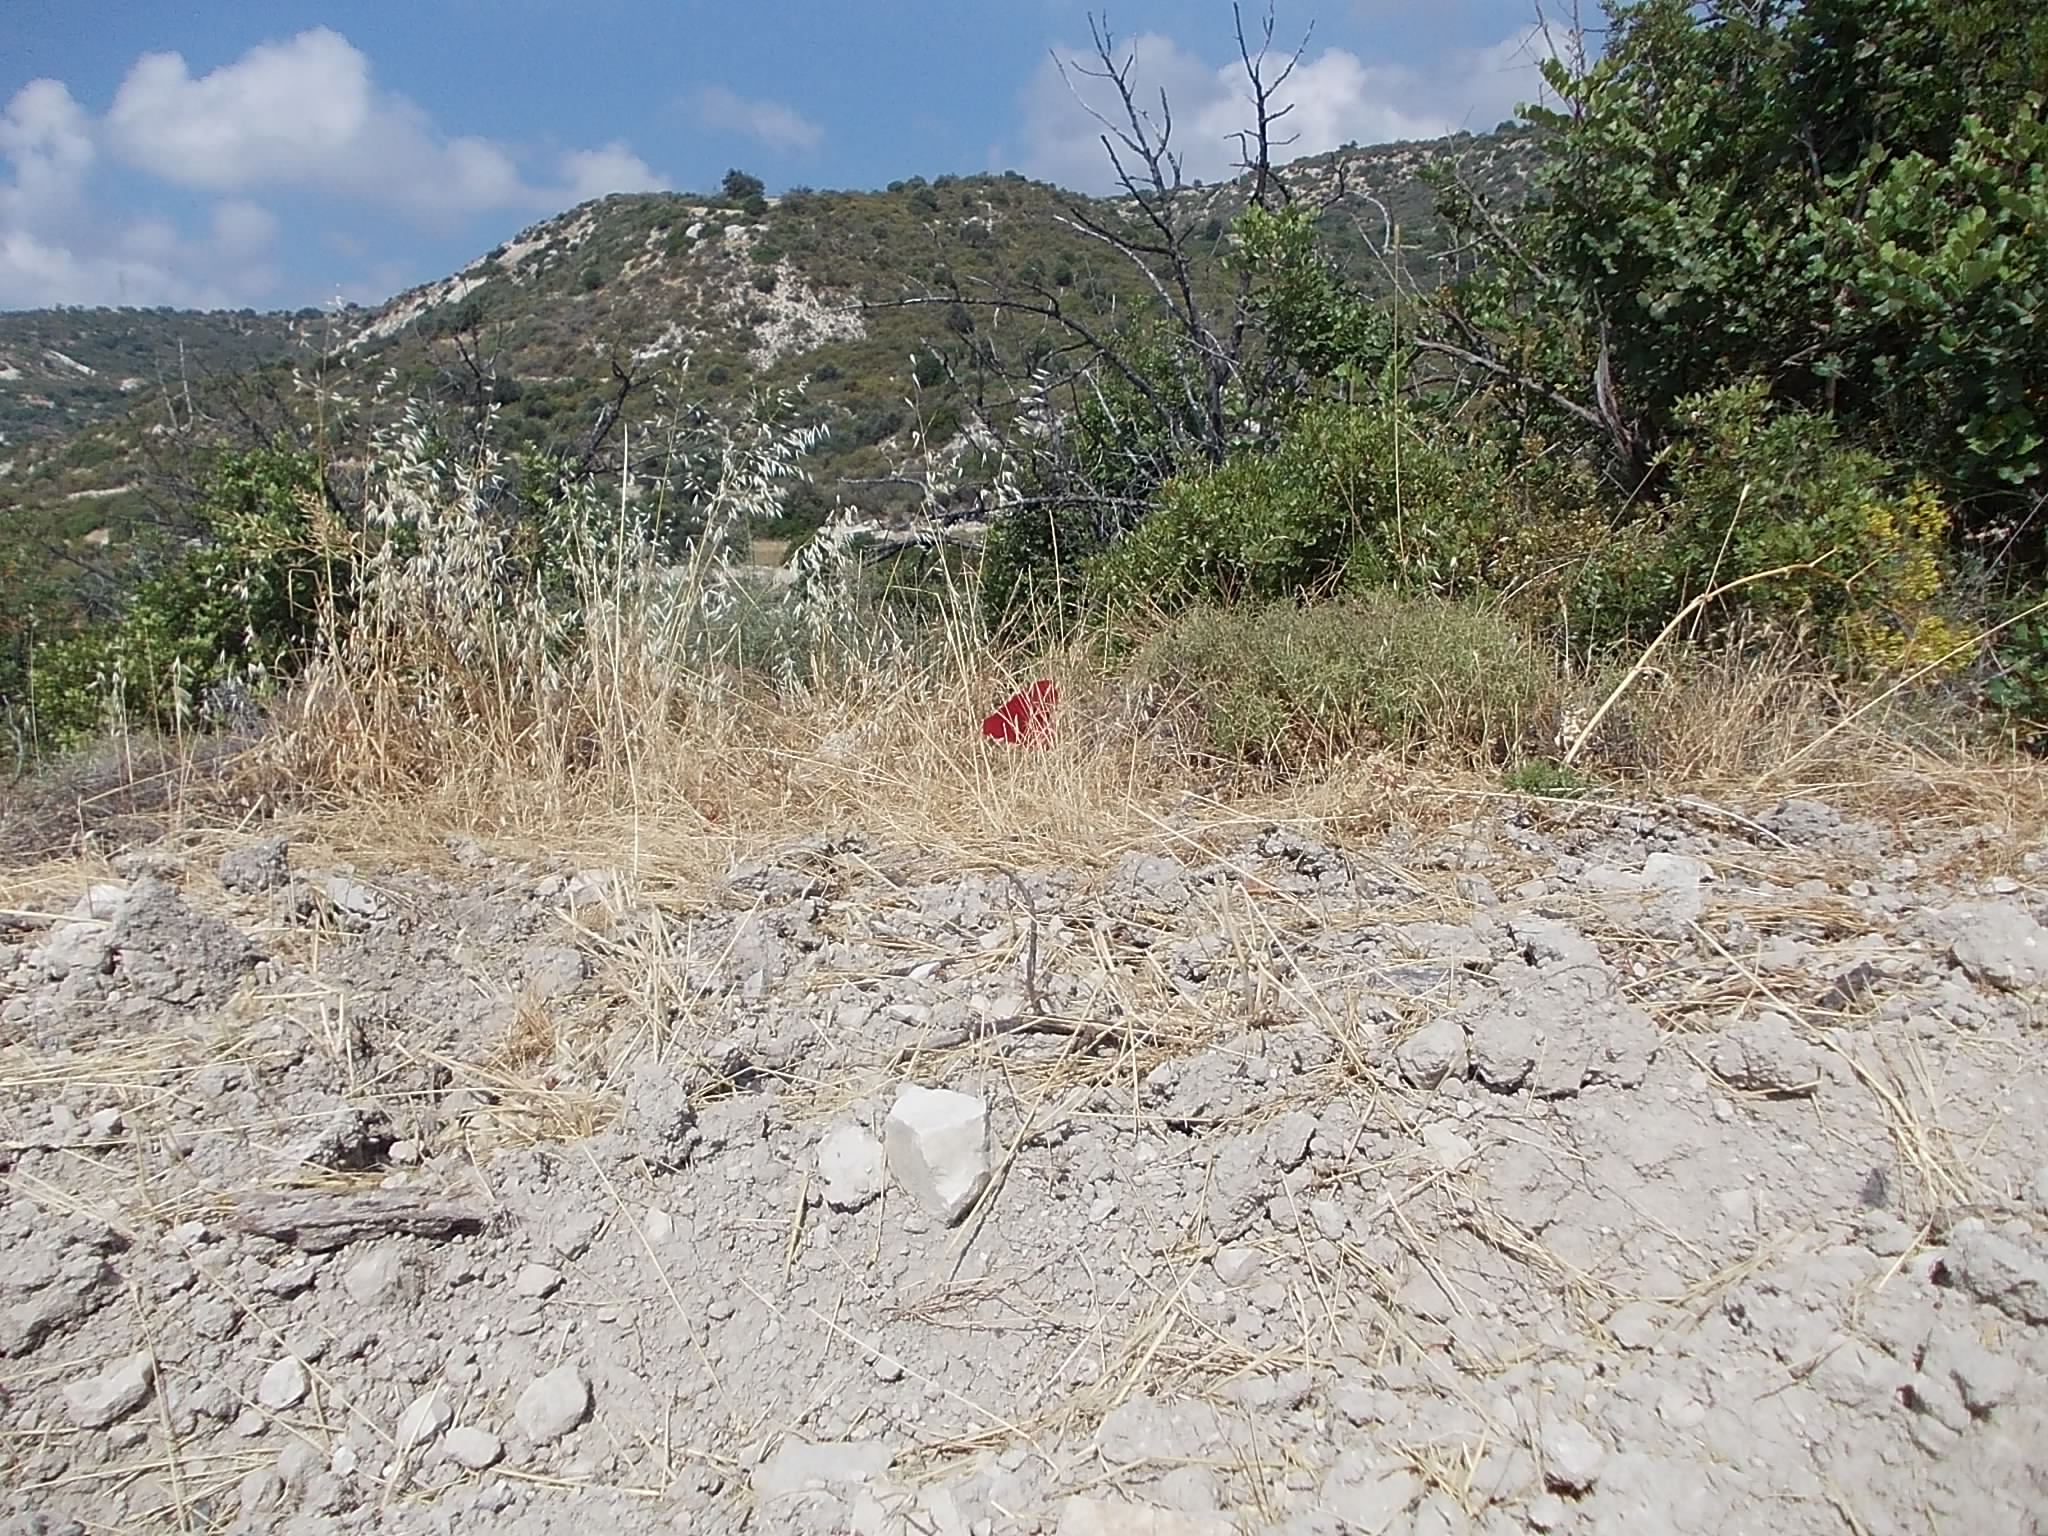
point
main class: Shrubland
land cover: Shrubland without tree cover
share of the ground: 25 - 50 %
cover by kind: shrubs 40 %, herbaceous plants 30 %, unconsolidated bare surface 30 %
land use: Semi-natural and natural areas not in use
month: June
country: CY
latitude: 34.7144
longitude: 32.7232
